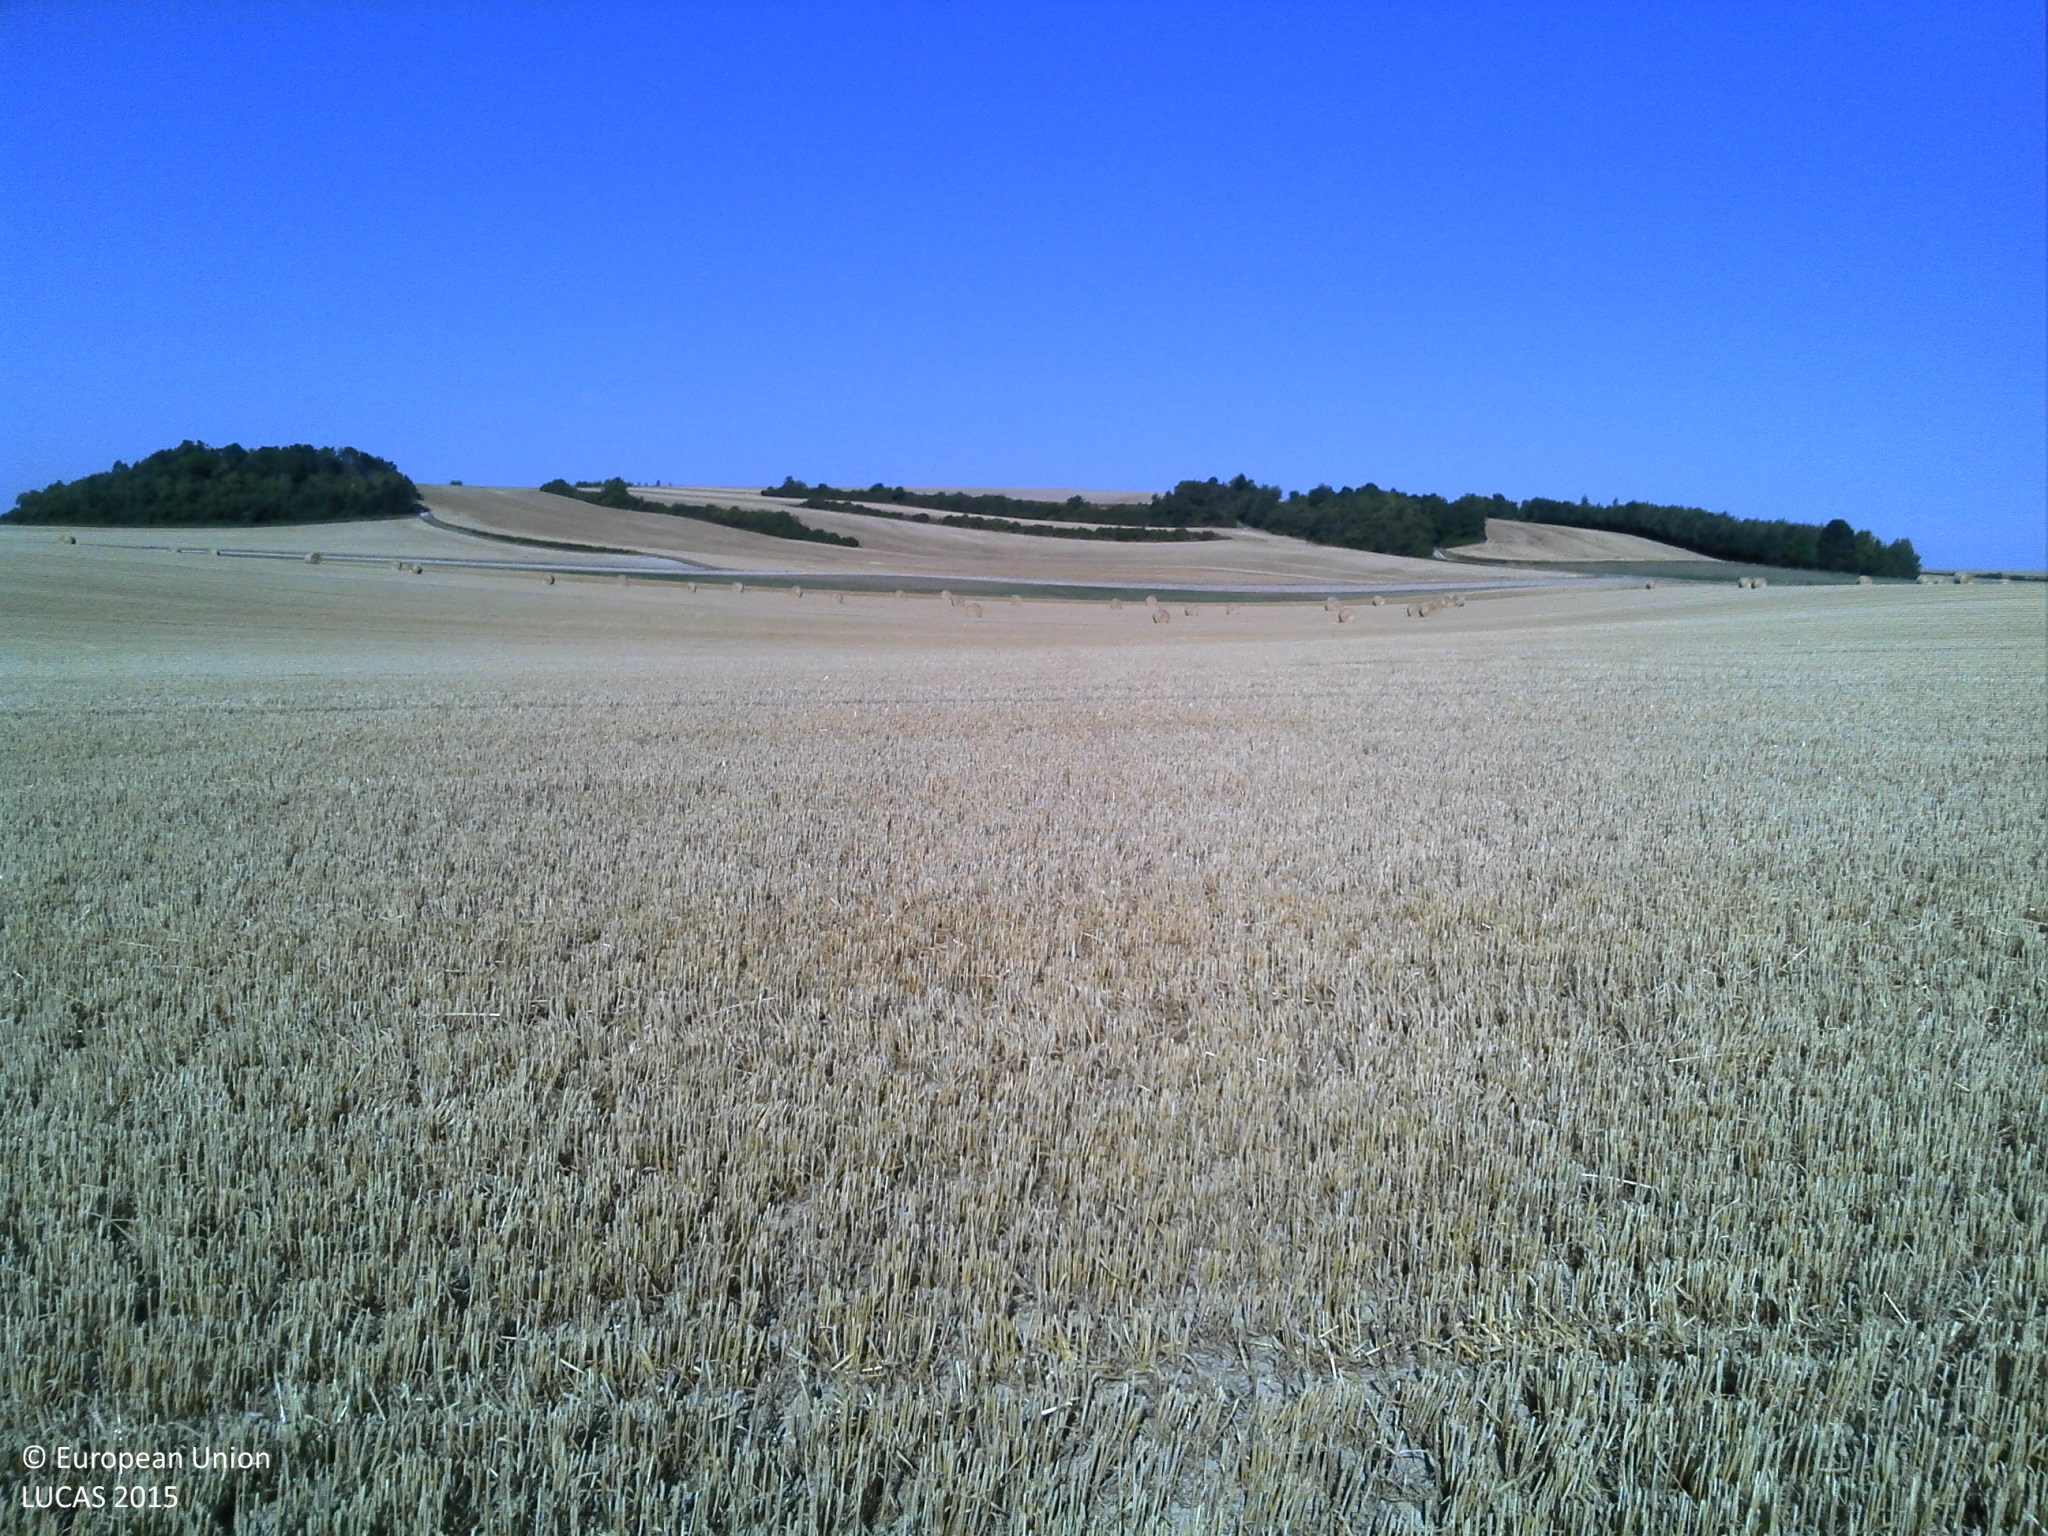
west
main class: Cropland
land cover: Barley
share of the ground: > 75 %
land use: Agriculture (excluding fallow land and kitchen gardens)
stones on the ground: < 10 %
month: August
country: FR
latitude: 49.1453
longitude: 4.7742
